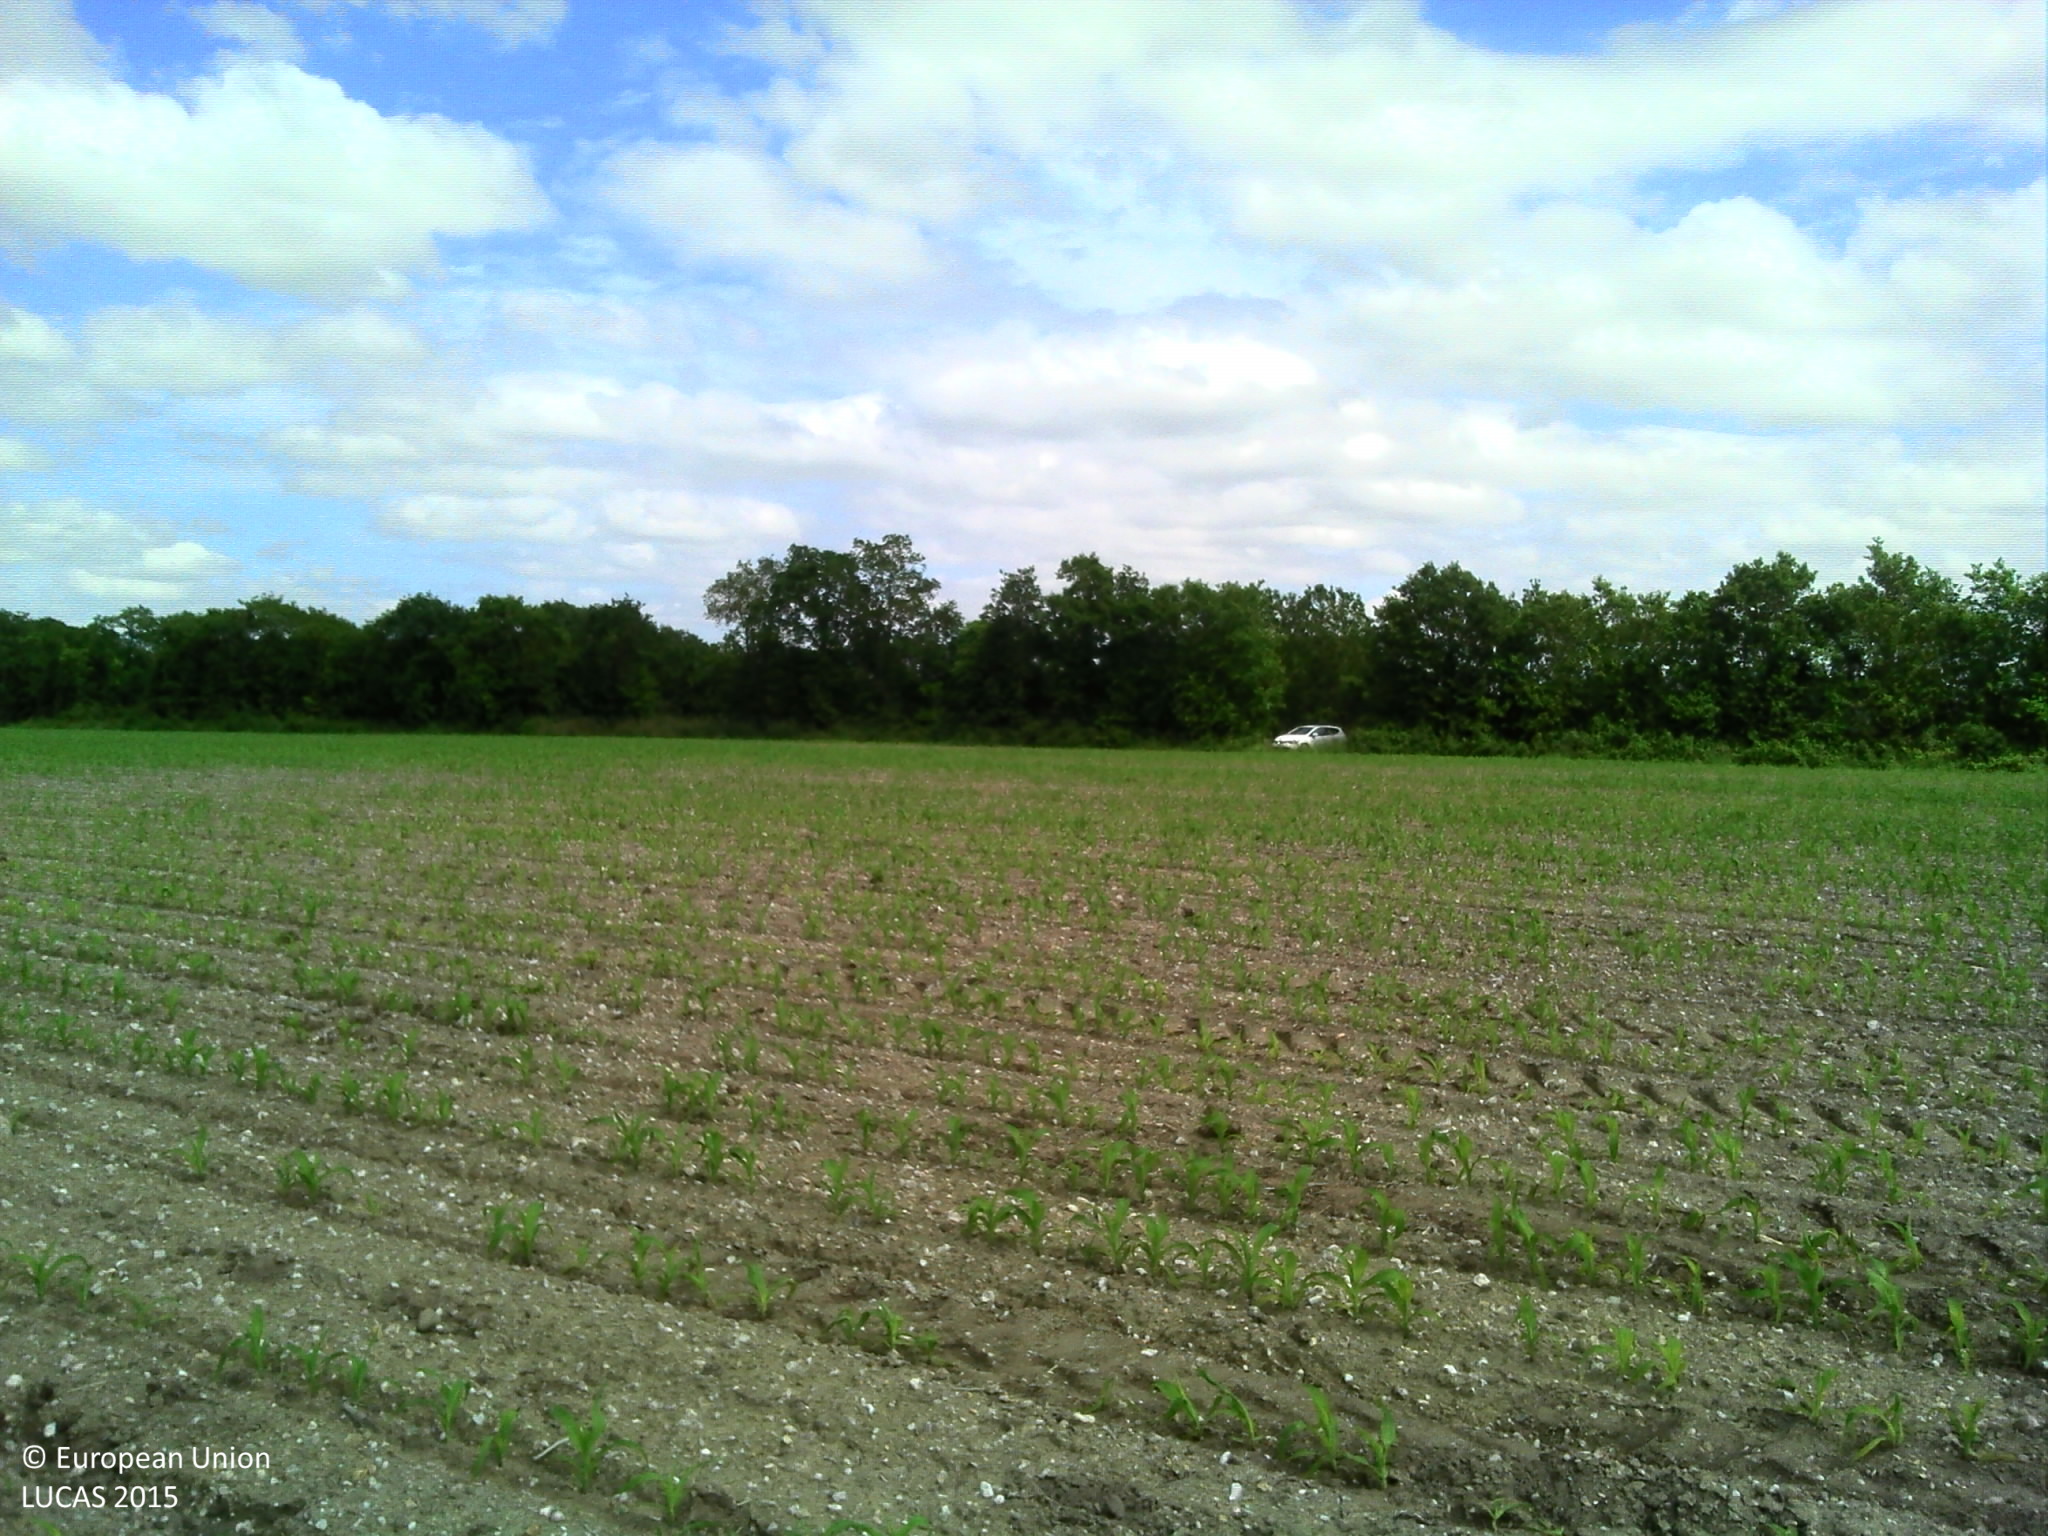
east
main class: Cropland
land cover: Maize
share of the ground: 10 - 25 %
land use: Agriculture (excluding fallow land and kitchen gardens)
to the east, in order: Maize; Lines of trees; Grass margins; Tracks; Grass margins; Lines of trees; Maize; Lines of trees; Grassland without tree/shrub cover
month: June
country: FR
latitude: 46.8679
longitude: -1.8912
